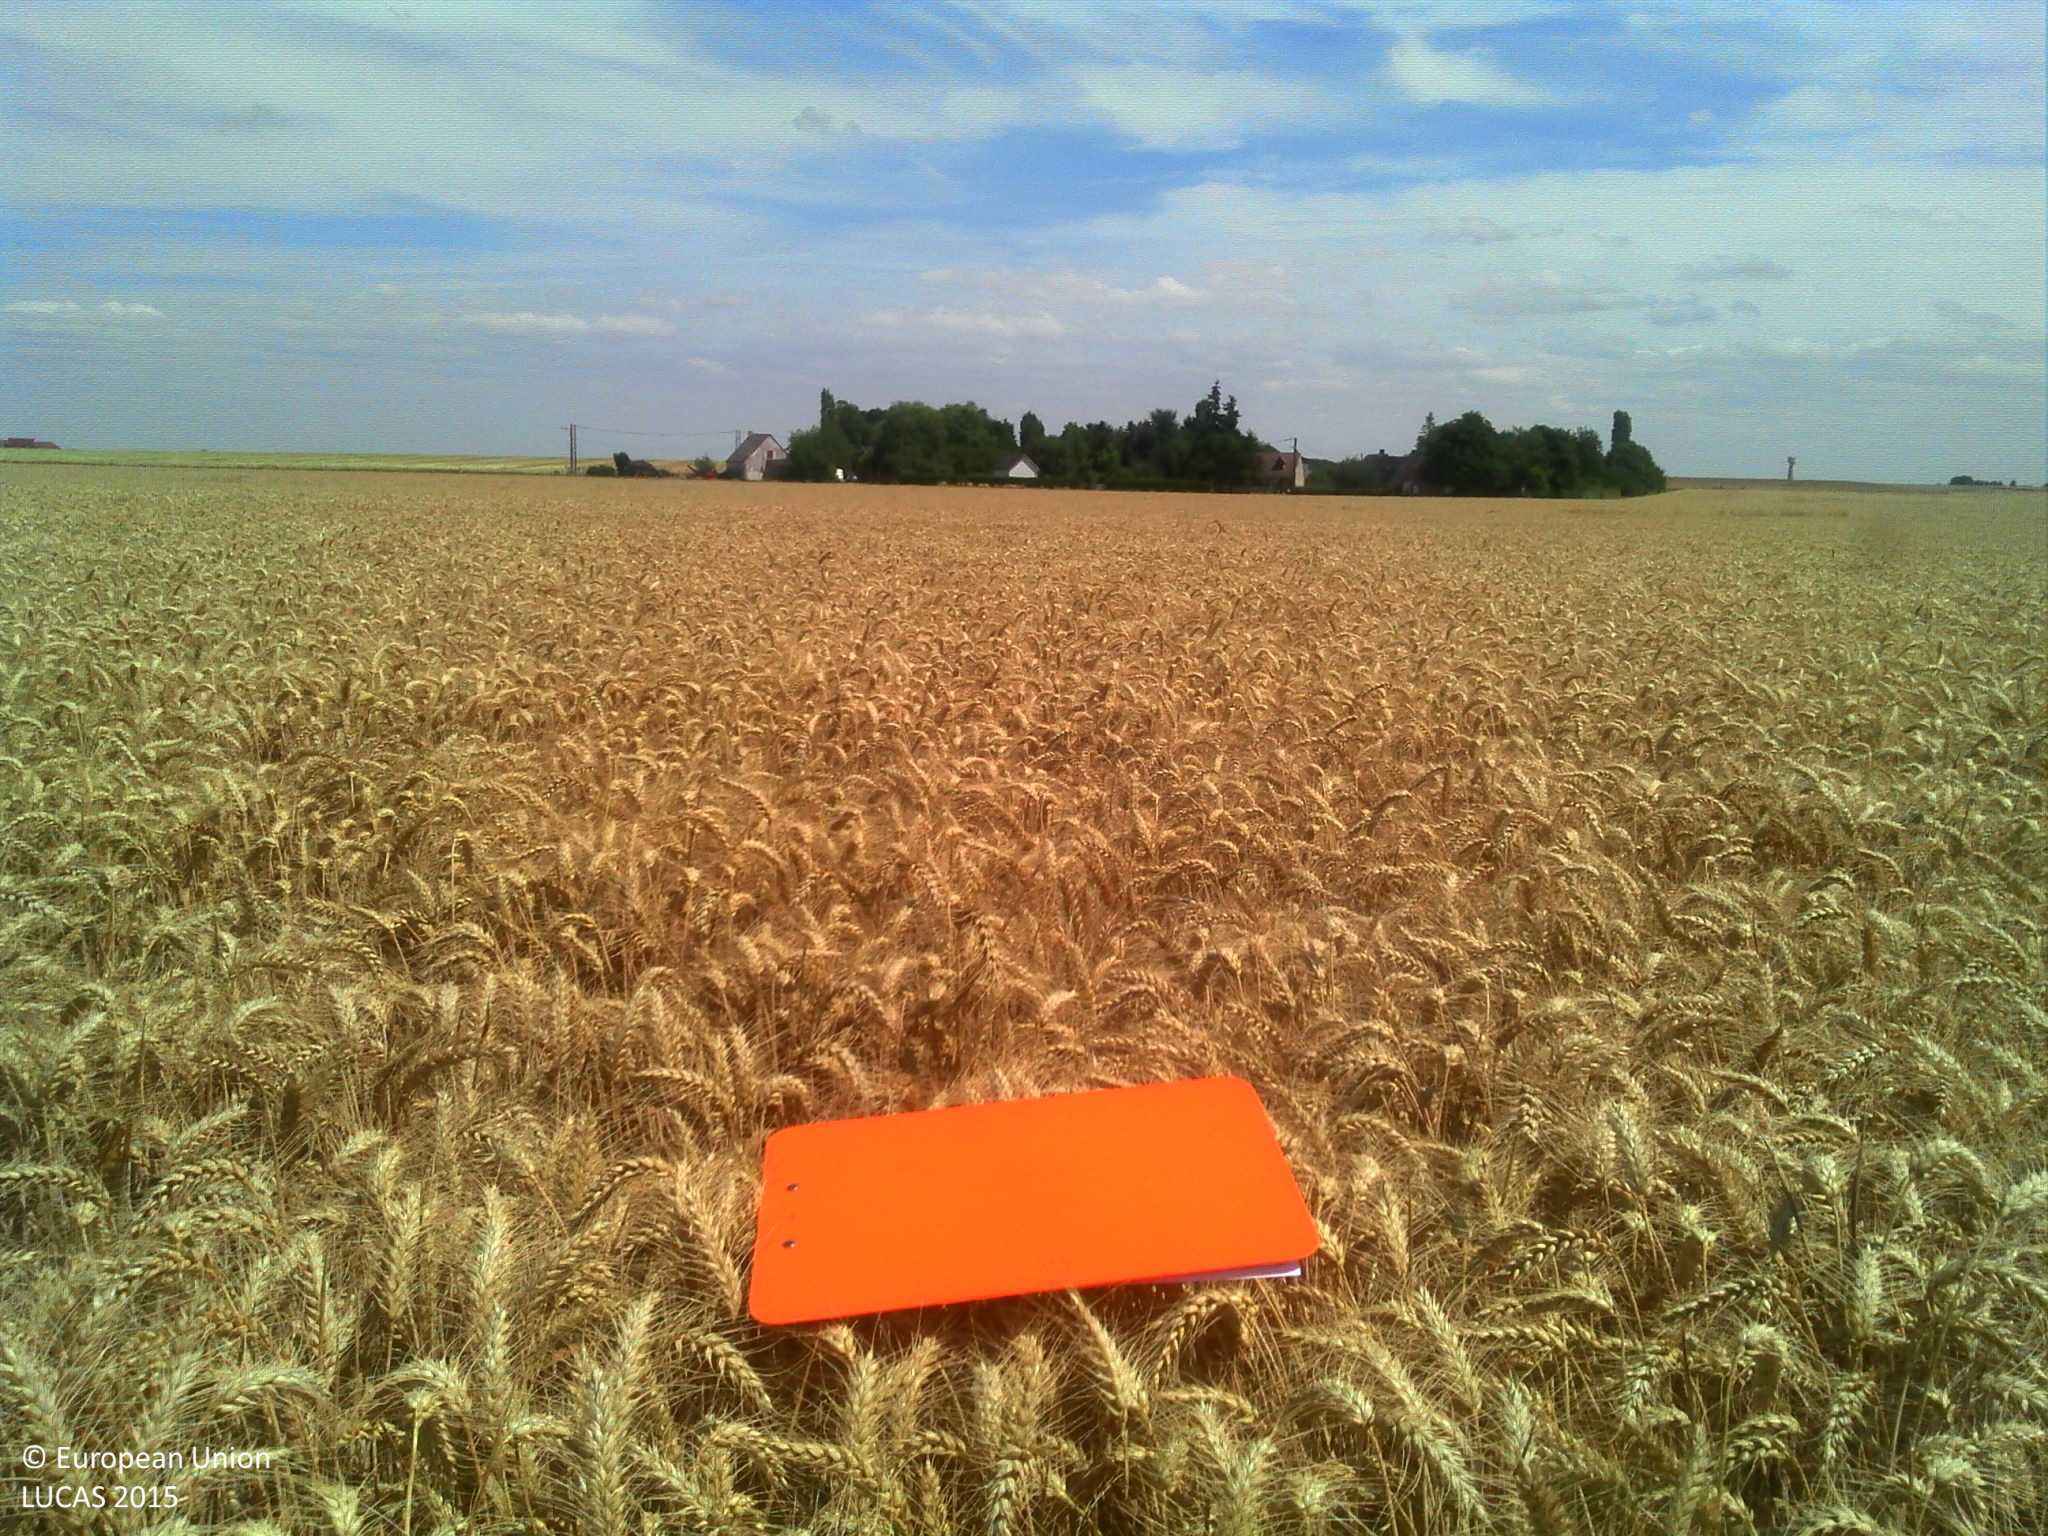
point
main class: Cropland
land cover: Common wheat
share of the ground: > 75 %
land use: Agriculture (excluding fallow land and kitchen gardens)
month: July
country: FR
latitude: 48.3636
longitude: 1.2488
